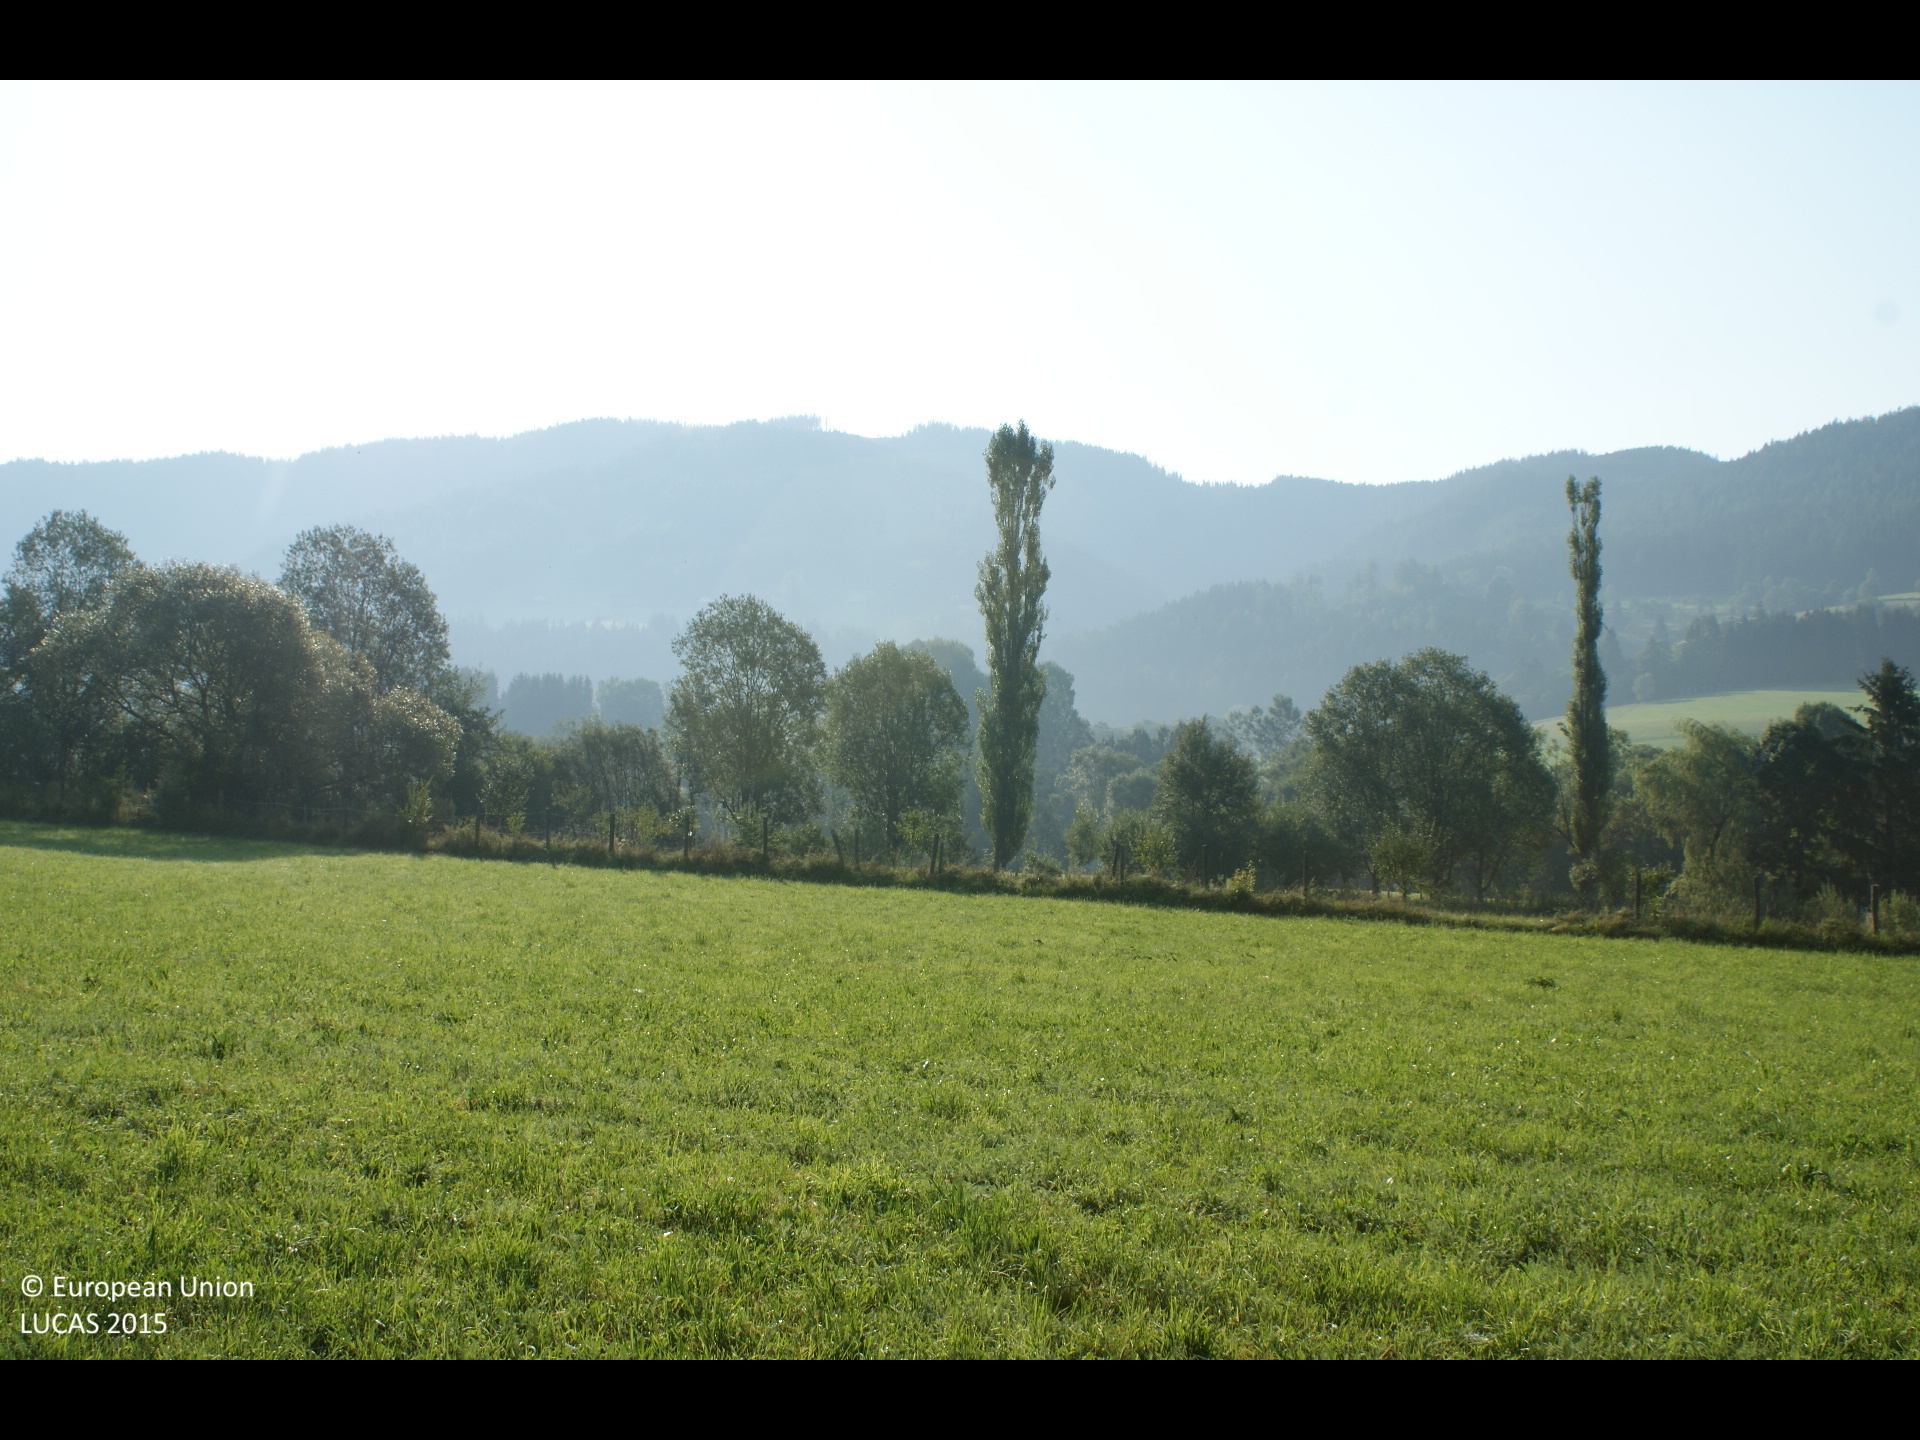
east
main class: Grassland
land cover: Grassland without tree/shrub cover
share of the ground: > 75 %
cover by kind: herbaceous plants 100 %
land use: Agriculture (excluding fallow land and kitchen gardens)
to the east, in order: Grassland without tree/shrub cover; Fences; Single bushes/trees; Inland fresh water bodies; Grassland without tree/shrub cover; Fences; Broadleaved woodland; Rivers and streams; Grassland without tree/shrub cover; Other bare soil; Grassland without tree/shrub cover
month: August
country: AT
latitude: 47.5536
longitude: 15.3294
